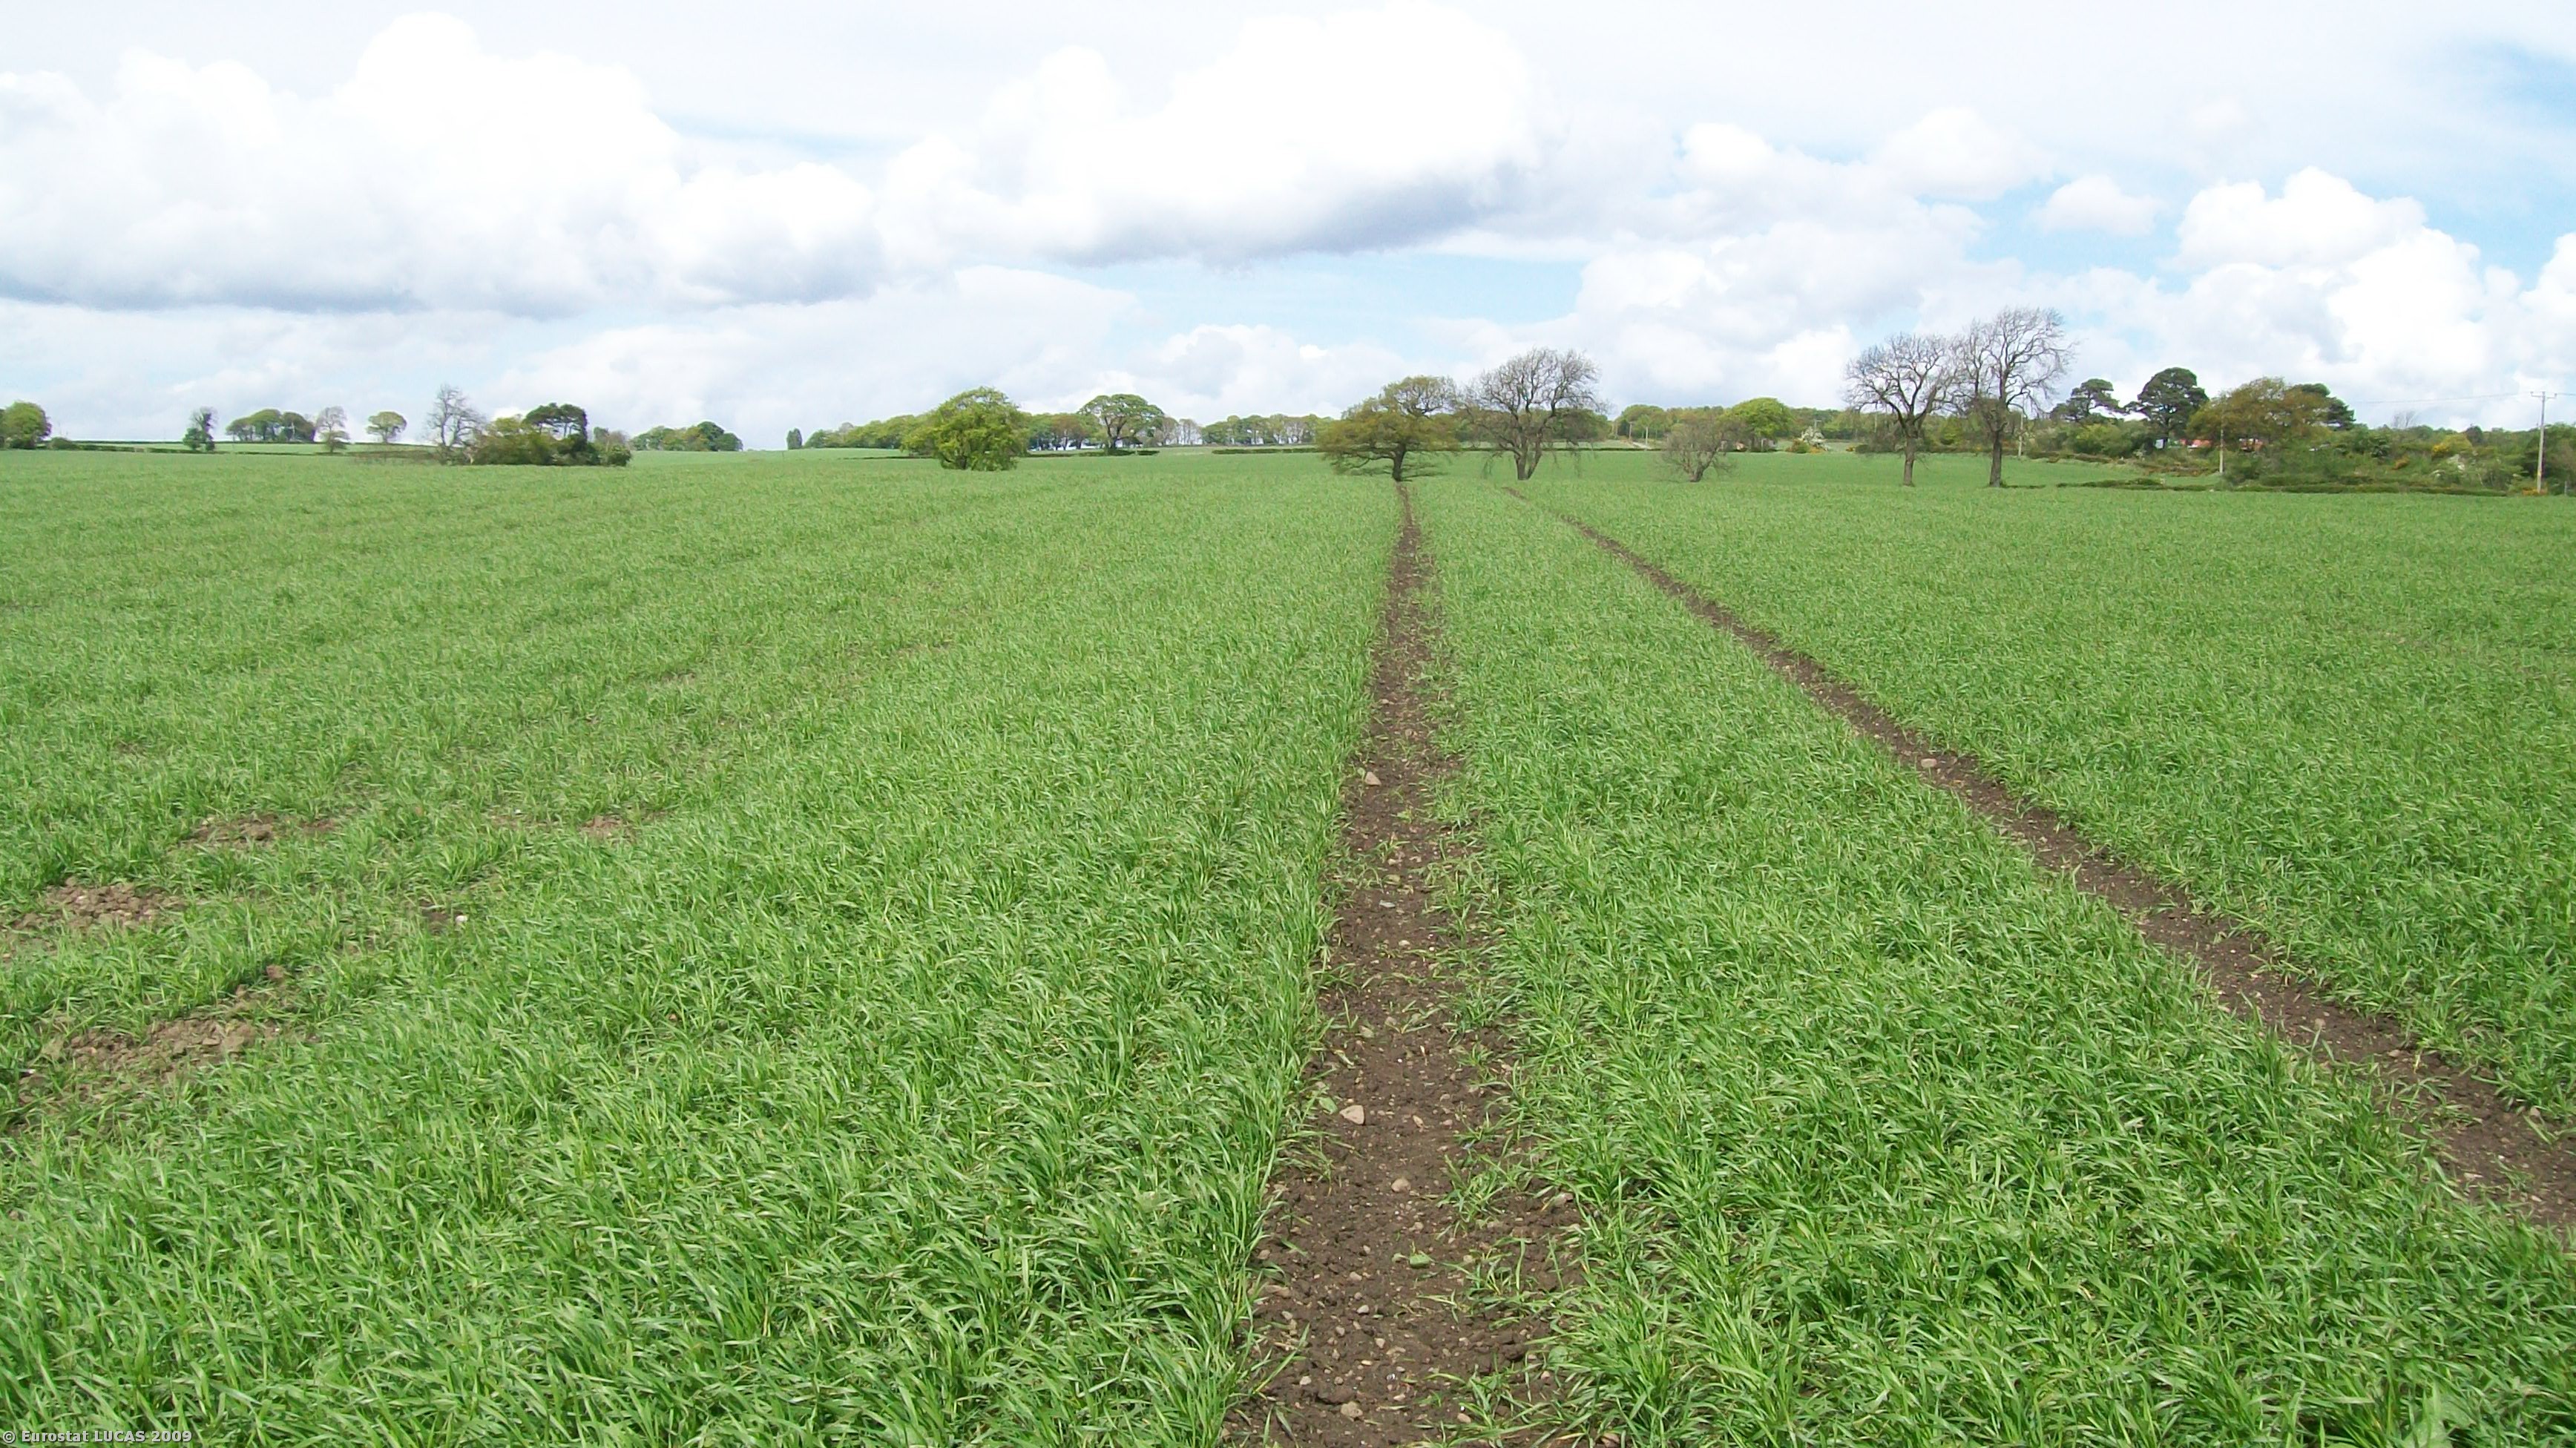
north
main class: Cropland
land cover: Barley
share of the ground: > 75 %
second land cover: Rape and turnip rape
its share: 50 - 75 %
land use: Agriculture (excluding fallow land and kitchen gardens)
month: May
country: GB
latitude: 55.9862
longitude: -3.6242
